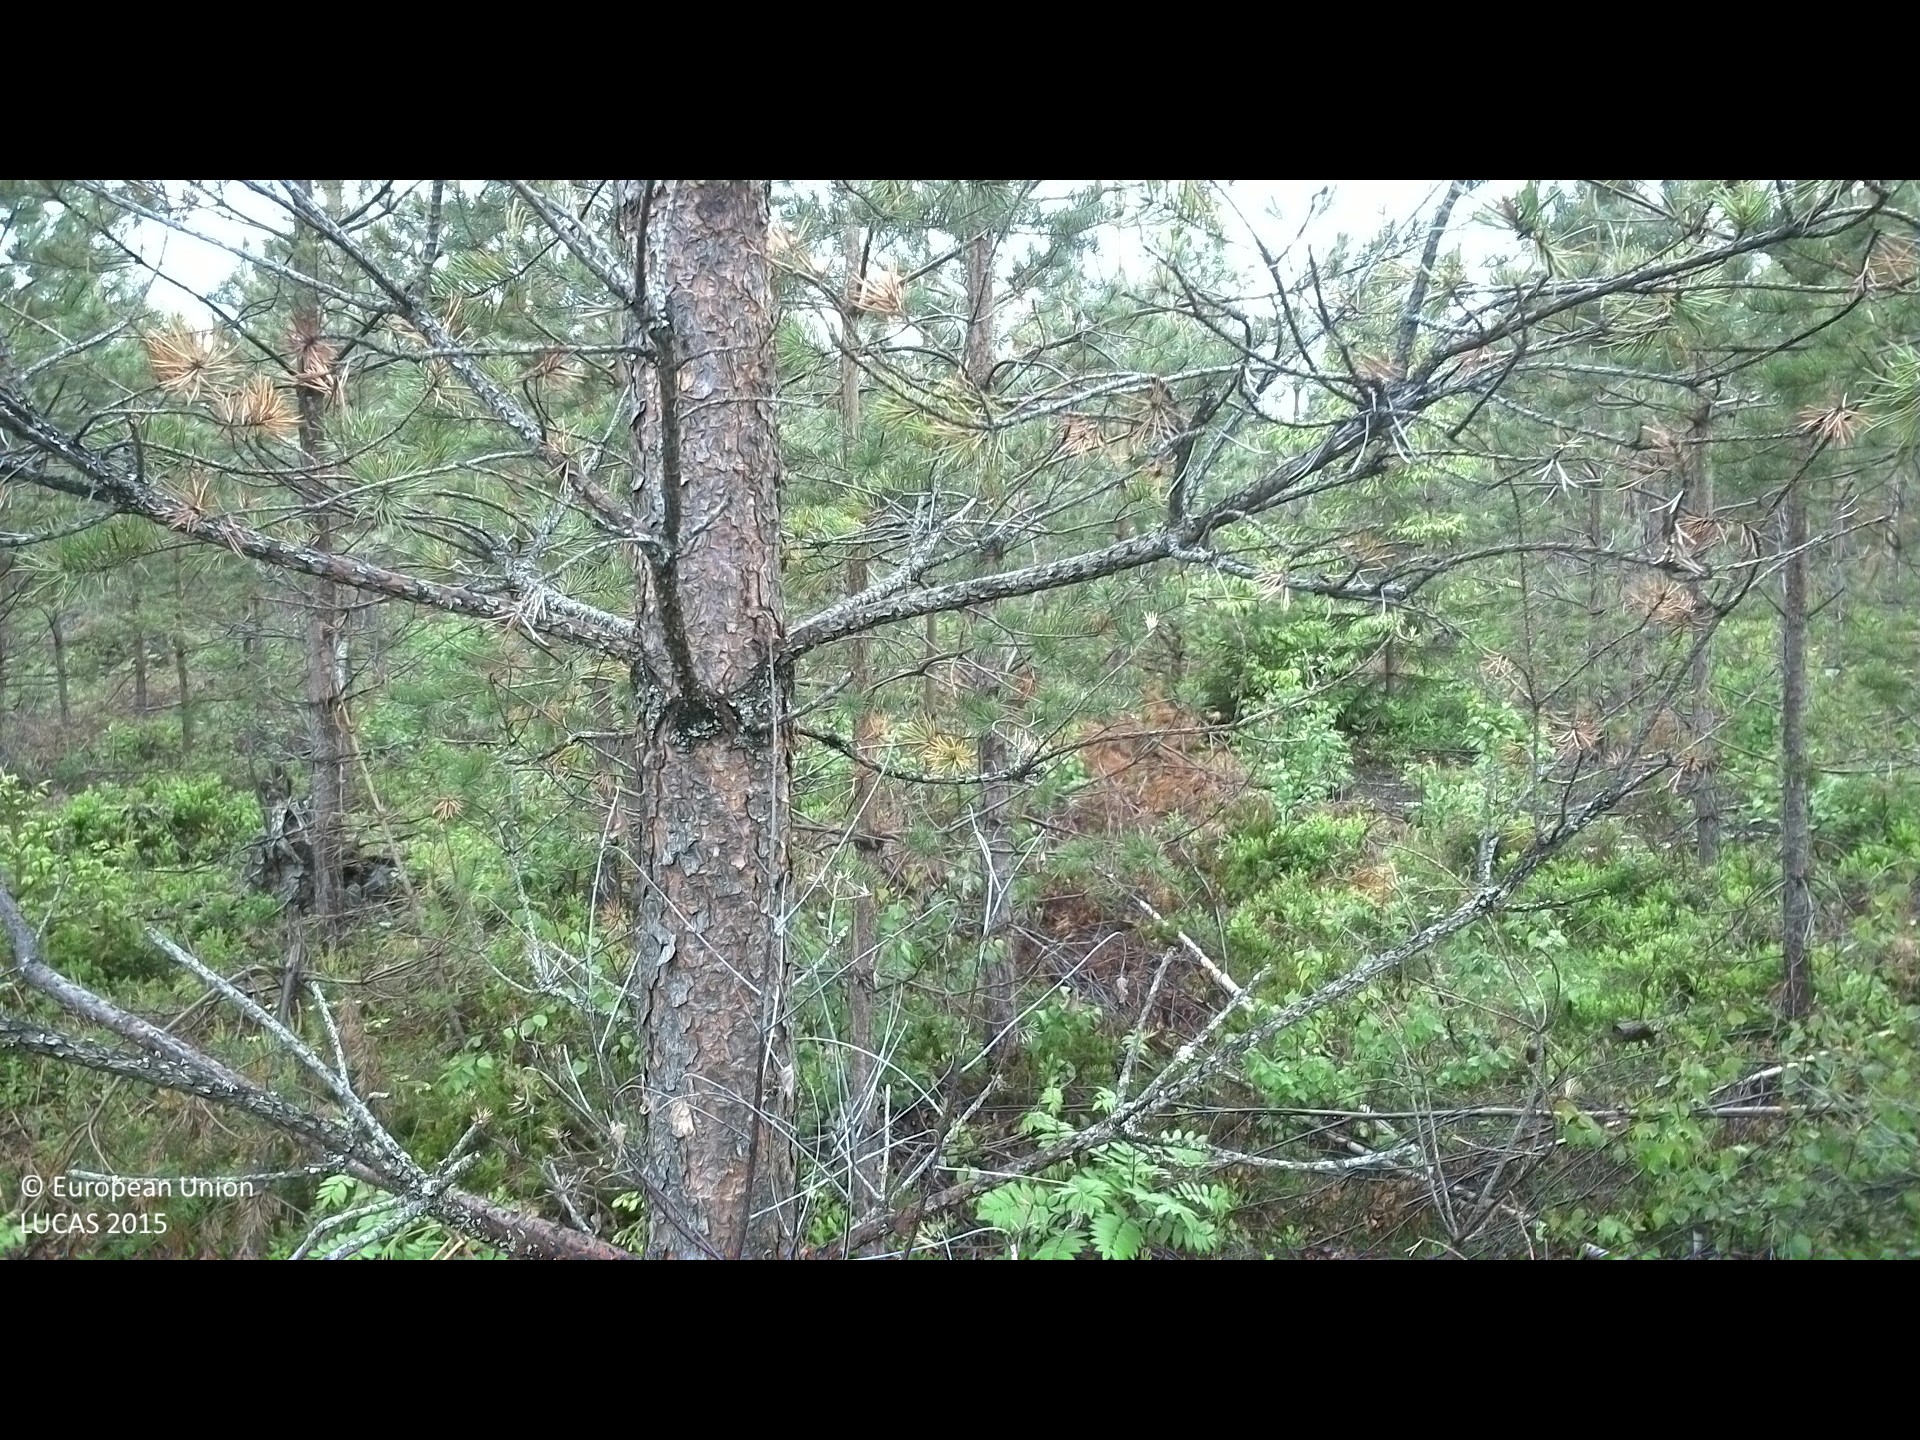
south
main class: Woodland
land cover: Pine dominated coniferous woodland
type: boreal forest
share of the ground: 25 - 50 %
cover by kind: herbaceous plants 40 %, shrubs 30 %, coniferous forest trees 25 %, broadleaved forest trees 5 %
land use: Forestry
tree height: < 5 m
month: June
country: SE
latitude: 61.8988
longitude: 17.1575
